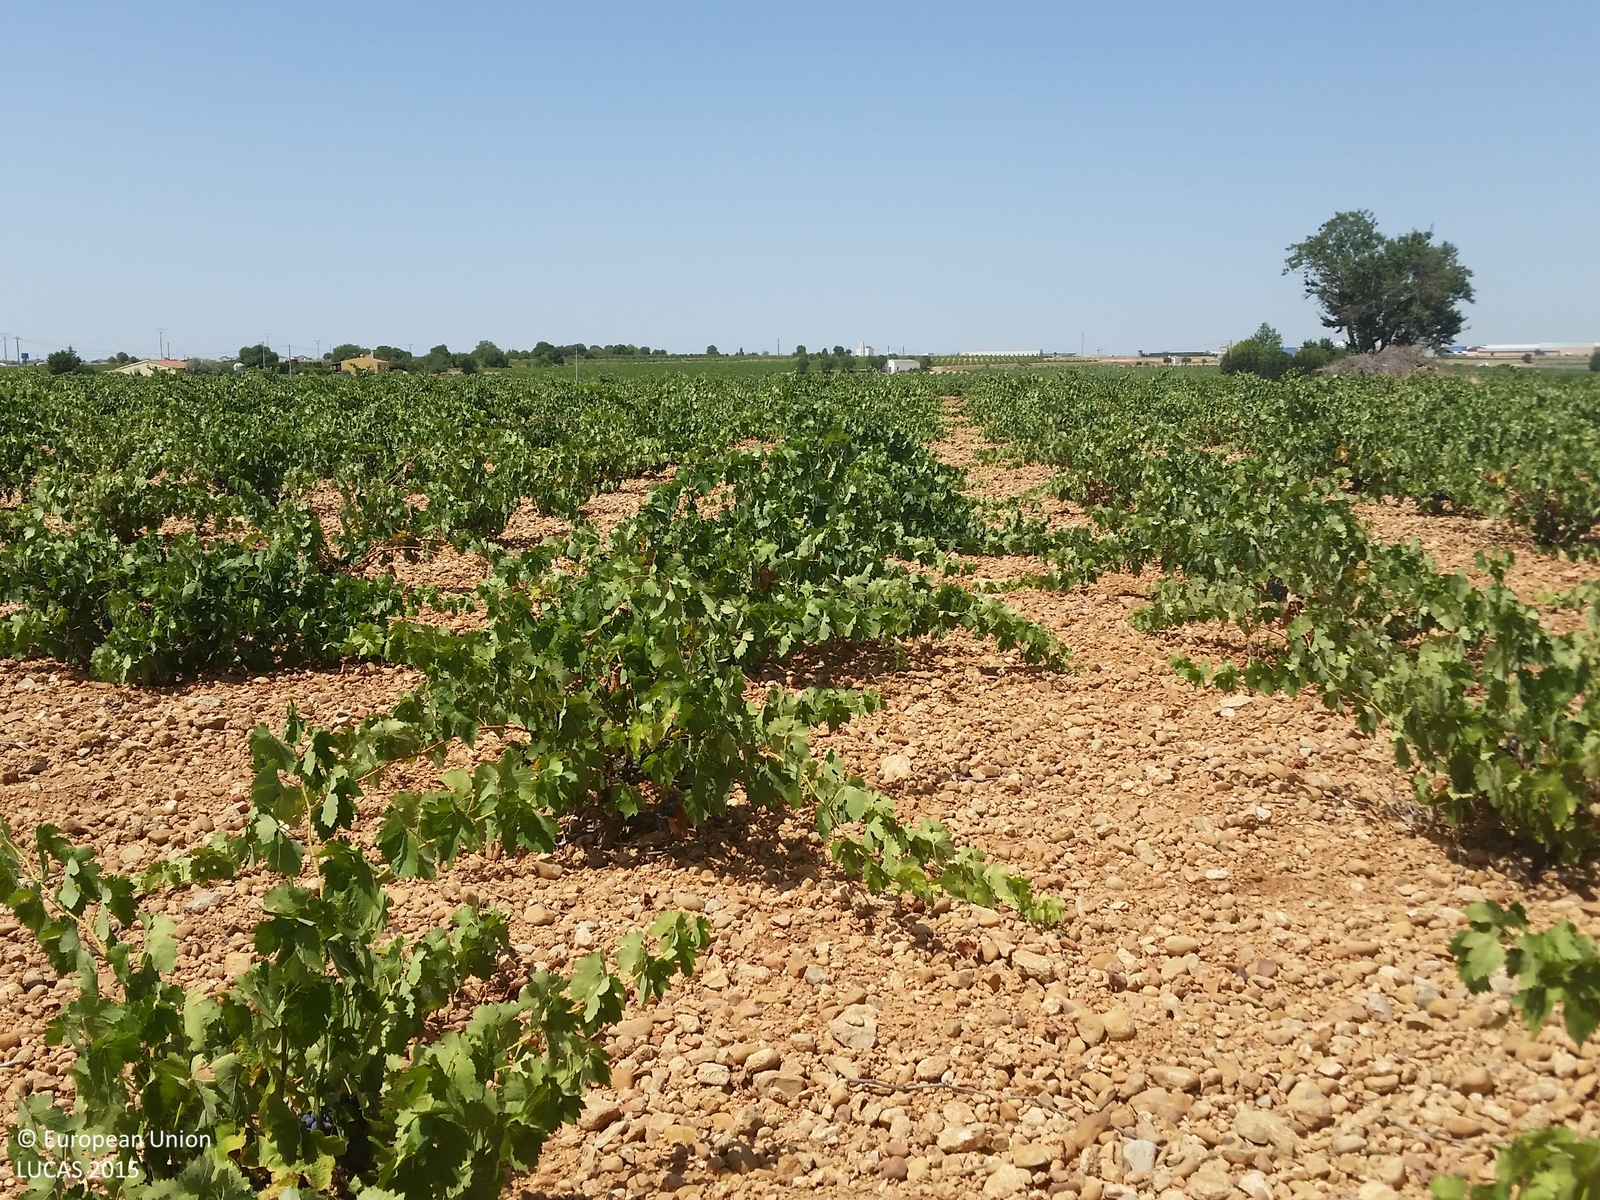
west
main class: Cropland
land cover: Vineyards
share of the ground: 50 - 75 %
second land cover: Other bare soil
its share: > 75 %
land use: Agriculture (excluding fallow land and kitchen gardens)
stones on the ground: 10 - 25 %
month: July
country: ES
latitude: 39.2733
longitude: -2.5633
